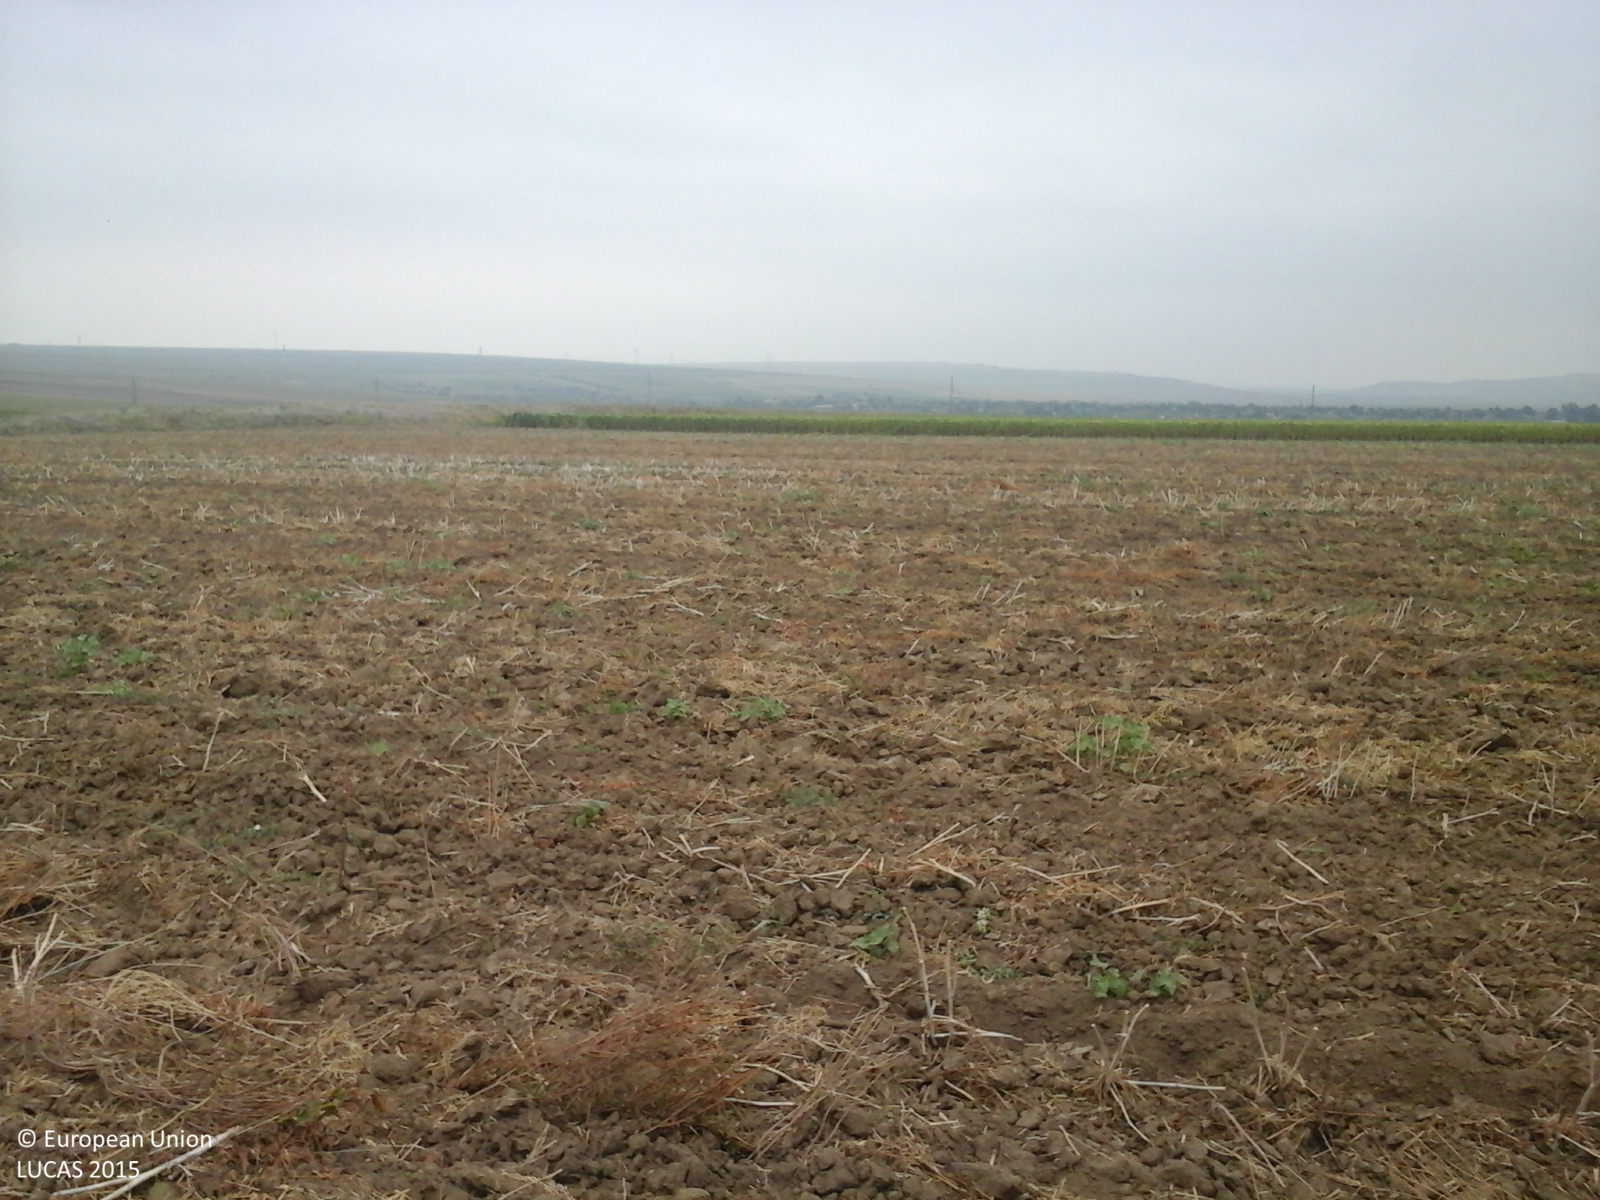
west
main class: Cropland
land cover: Rape and turnip rape
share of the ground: 10 - 25 %
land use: Agriculture (excluding fallow land and kitchen gardens)
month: August
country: RO
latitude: 44.8467
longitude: 28.3020
